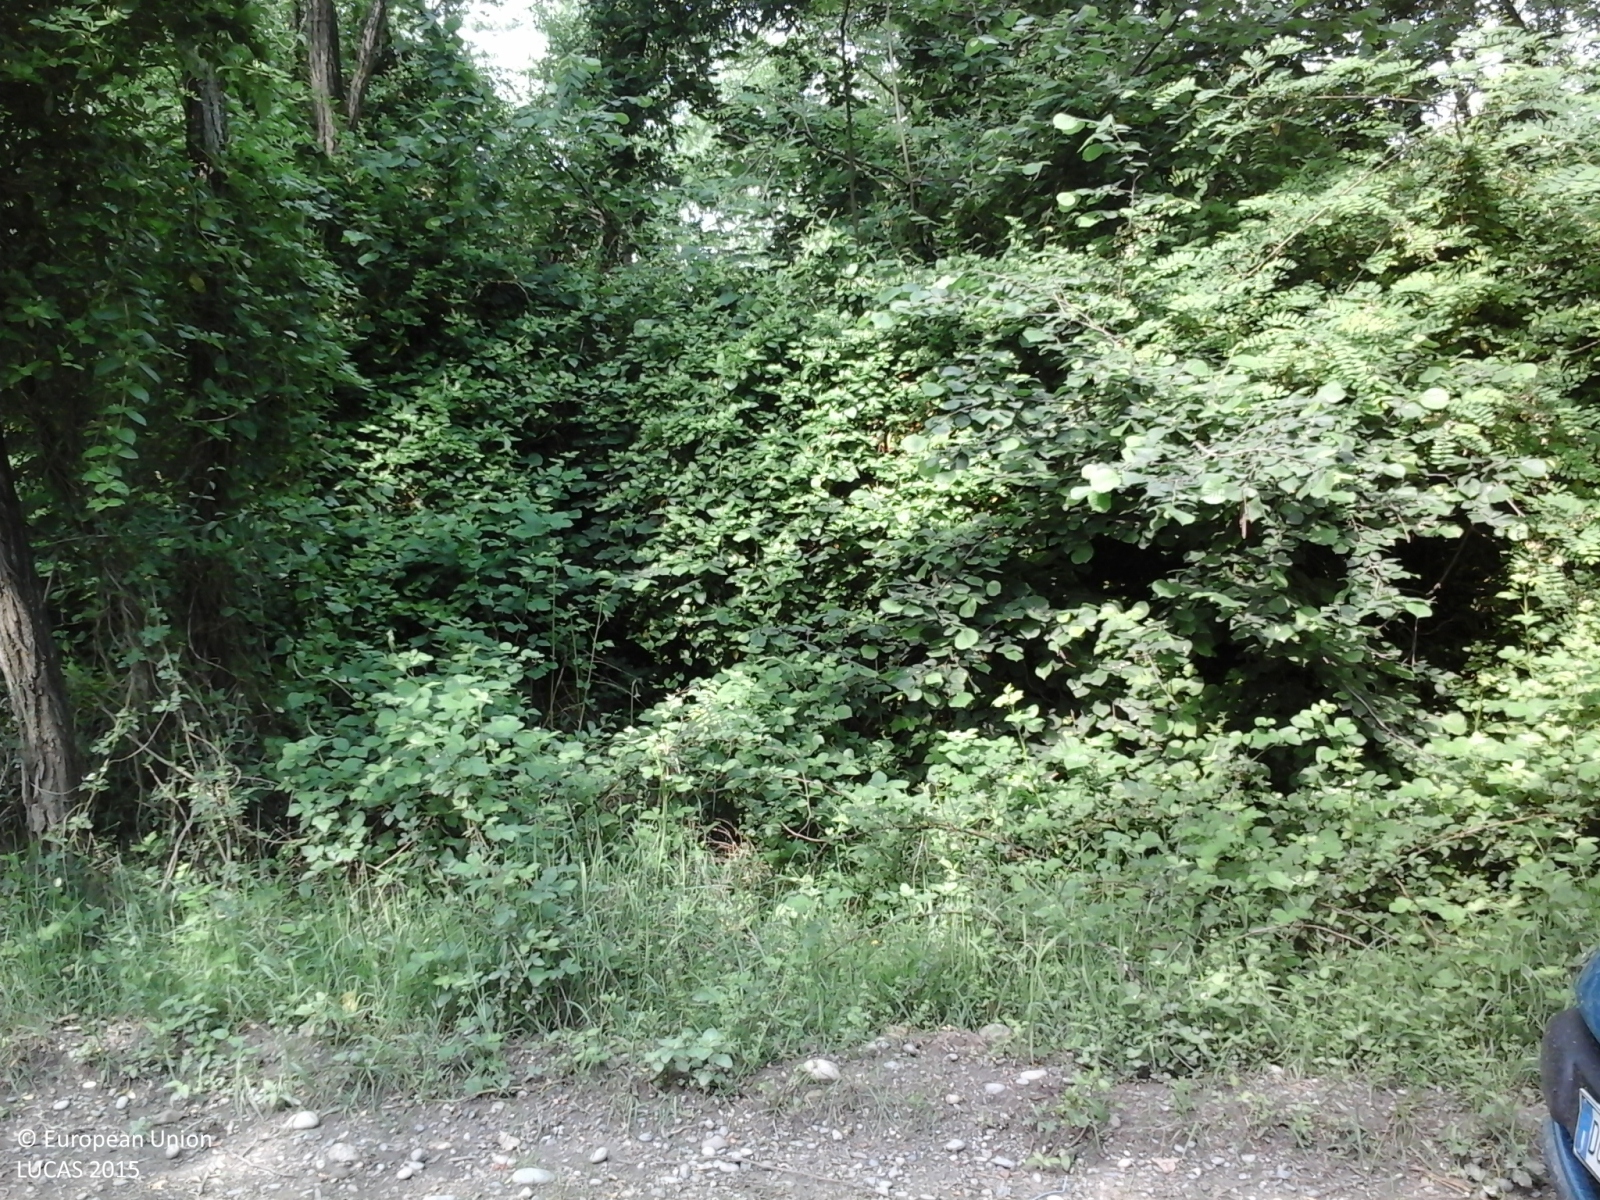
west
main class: Woodland
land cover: Broadleaved woodland
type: thermophilous deciduous forest
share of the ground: > 75 %
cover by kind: broadleaved forest trees 100 %
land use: Forestry
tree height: > 5 m
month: May
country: IT
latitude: 45.5284
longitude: 8.4021
